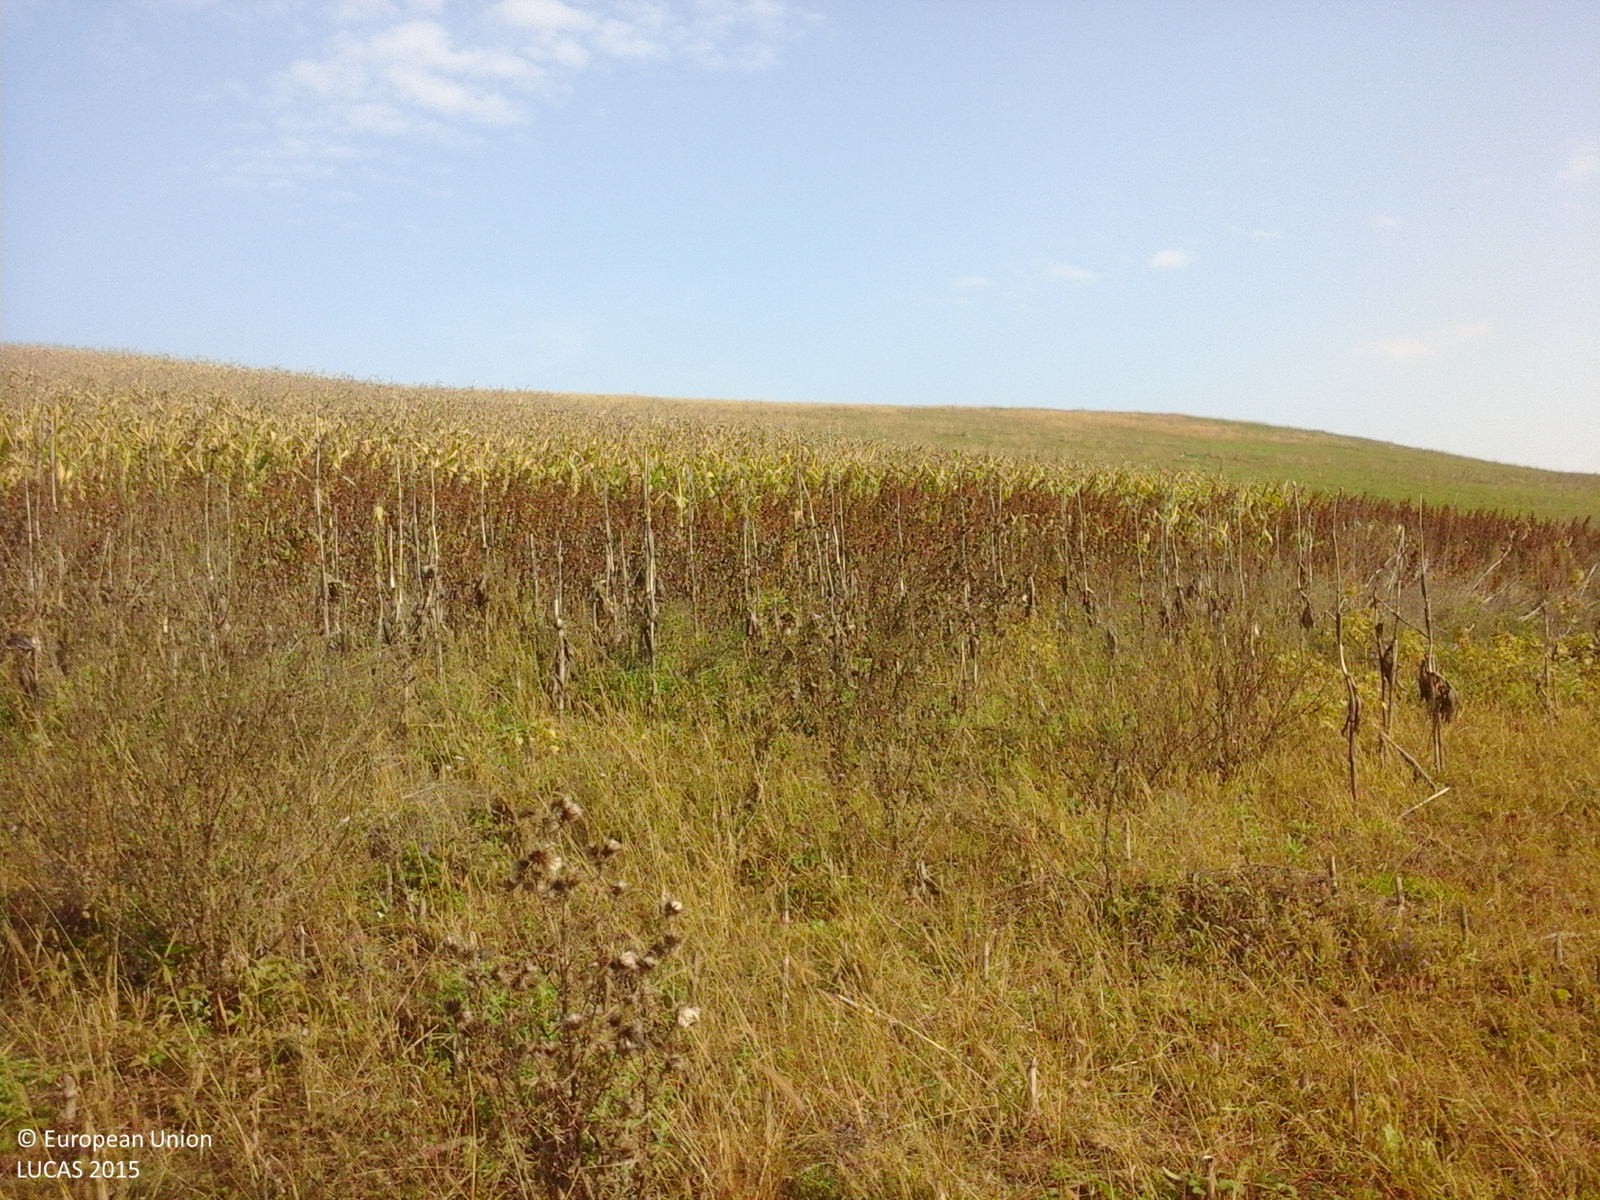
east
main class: Grassland
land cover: Spontaneously vegetated surfaces
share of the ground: > 75 %
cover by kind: herbaceous plants 100 %
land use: Agriculture (excluding fallow land and kitchen gardens)
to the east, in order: Spontaneously vegetated surfaces; Maize; Grassland without tree/shrub cover; Common wheat
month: October
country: RO
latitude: 46.6720
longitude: 24.2391
